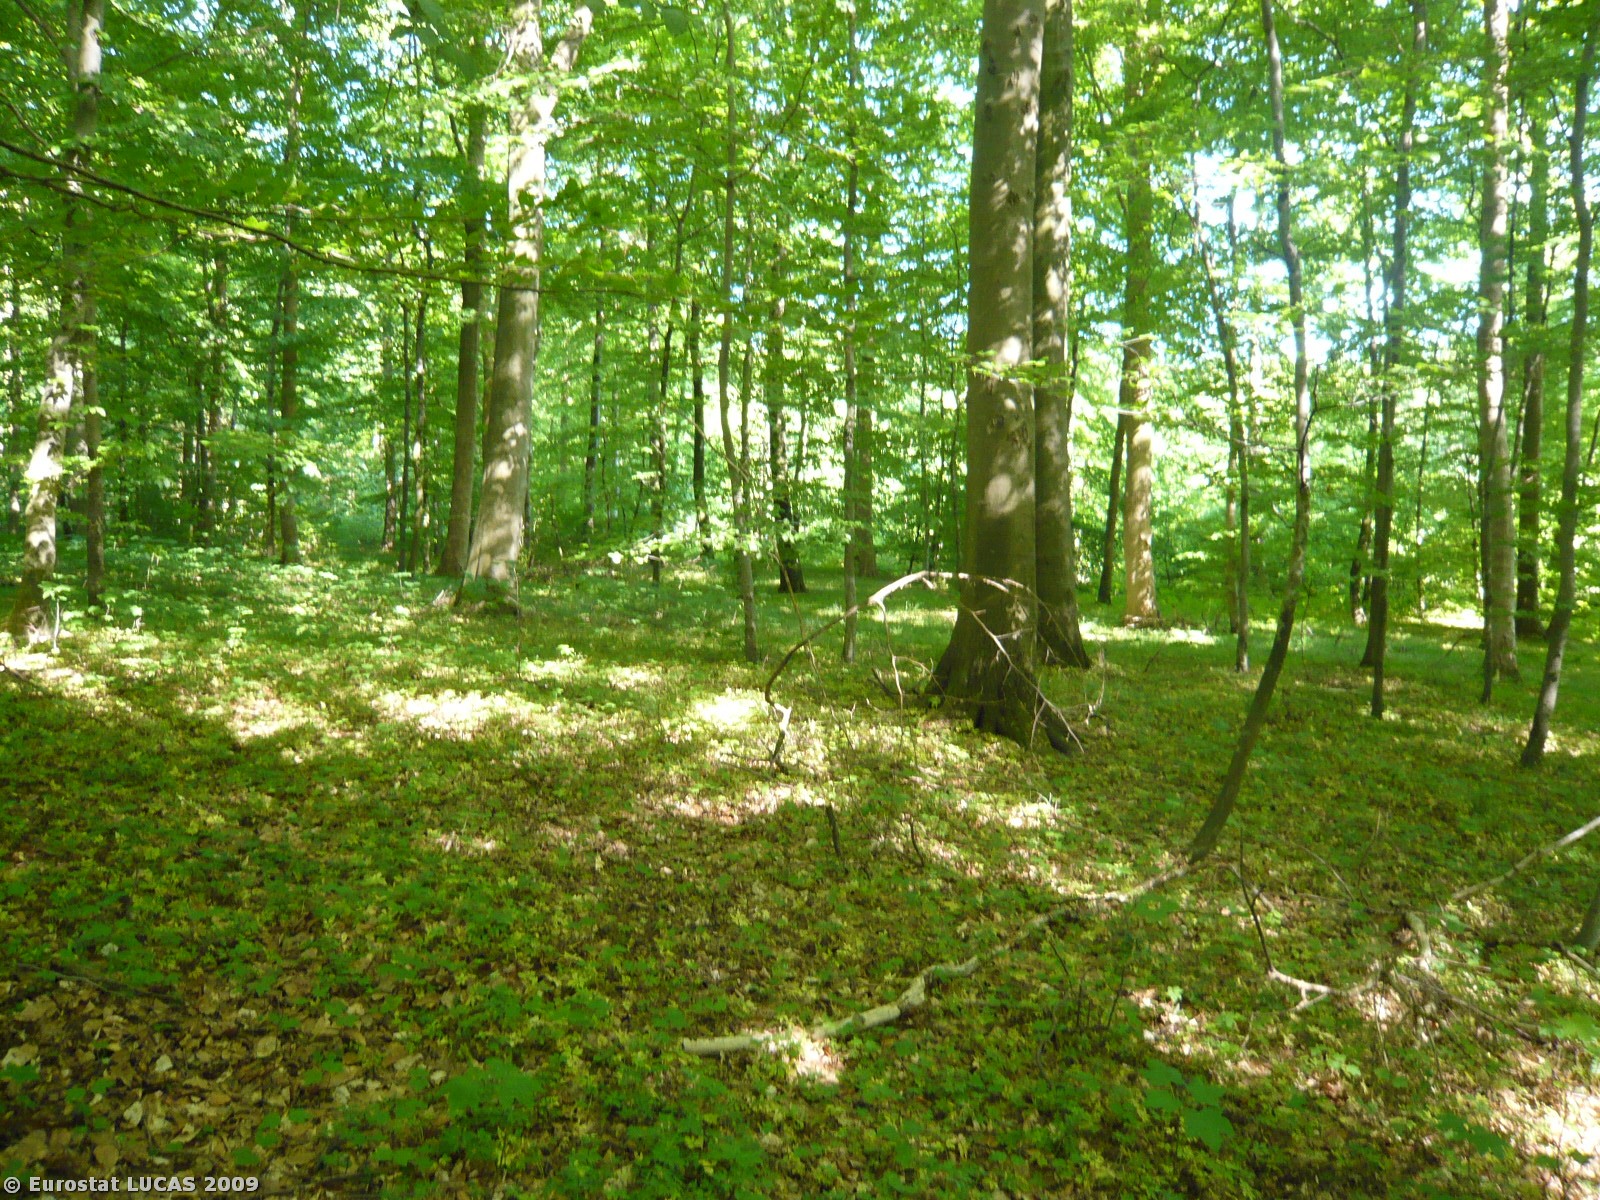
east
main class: Woodland
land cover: Broadleaved woodland
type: mesophytic deciduous forest
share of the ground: > 75 %
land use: Forestry
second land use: Amenities, museums, leisure
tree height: > 5 m
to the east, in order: Broadleaved woodland; Ditches and canals; Broadleaved woodland
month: May
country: DK
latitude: 55.2765
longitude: 11.7774
